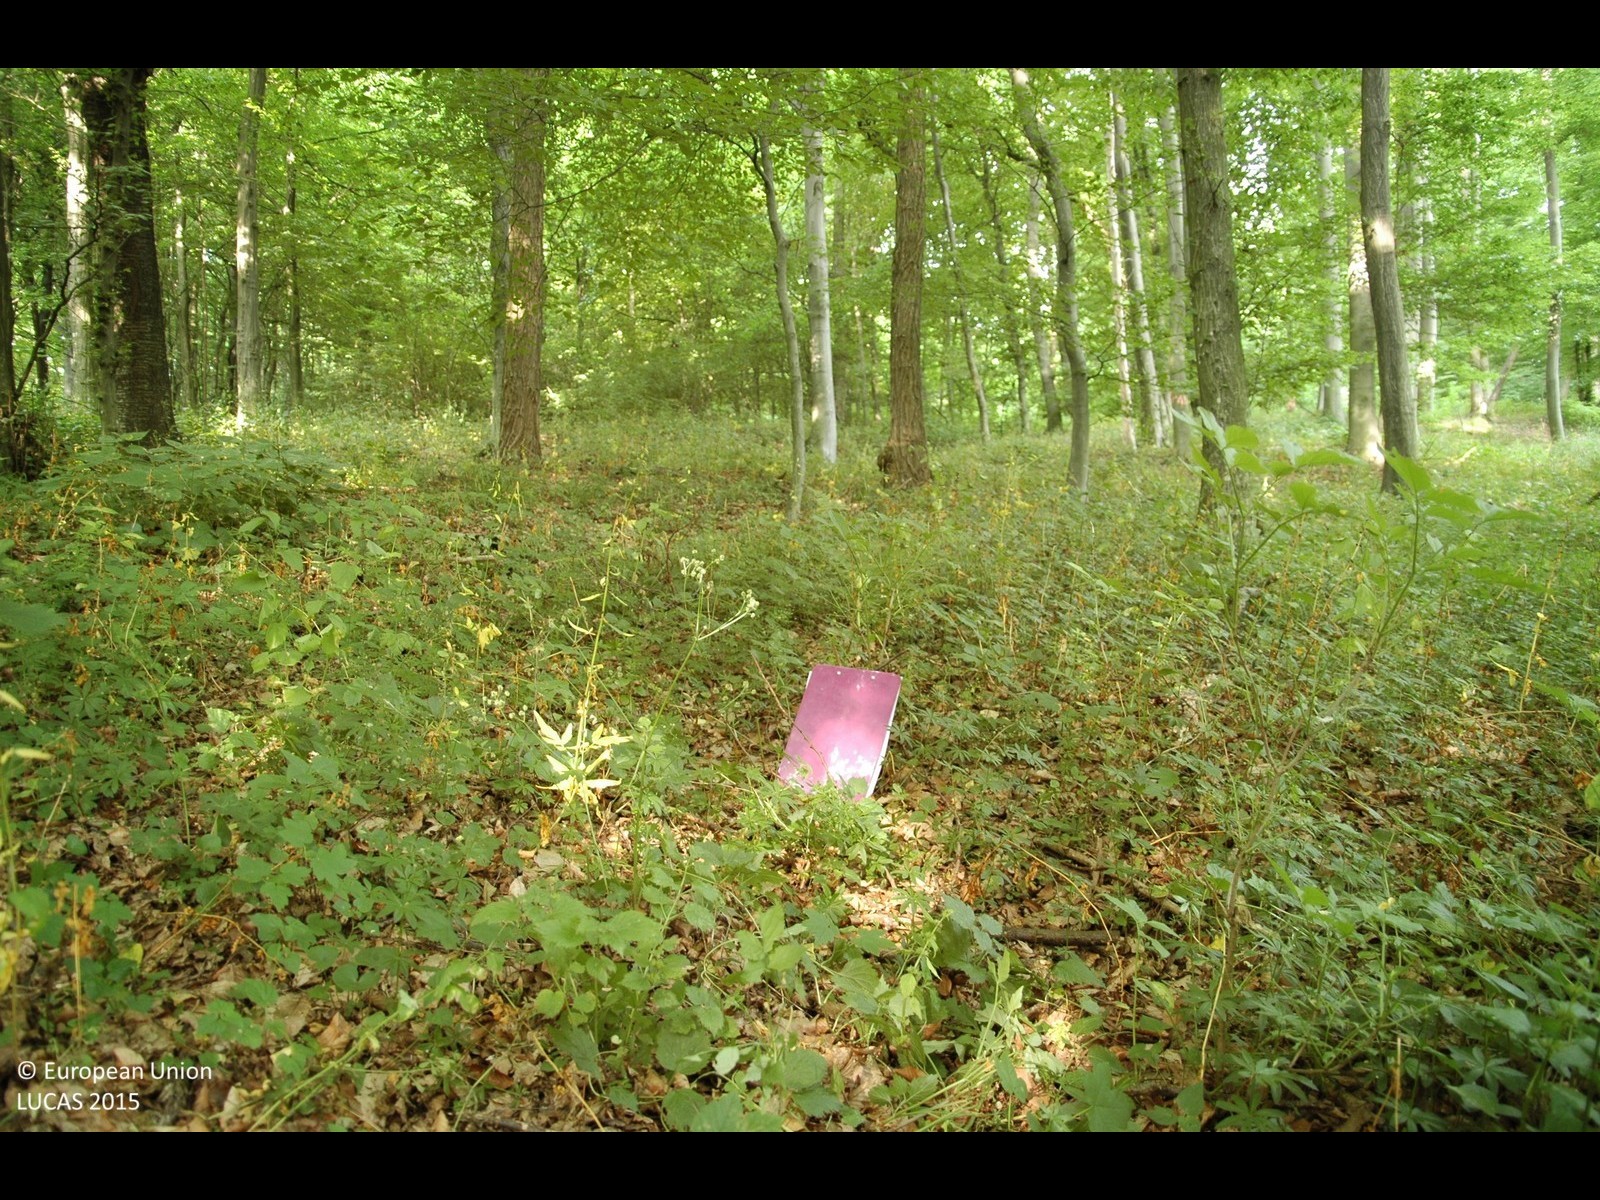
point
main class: Woodland
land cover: Broadleaved woodland
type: beech forest
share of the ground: > 75 %
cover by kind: broadleaved forest trees 100 %
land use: Forestry
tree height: > 5 m
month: June
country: HR
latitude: 46.4879
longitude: 16.3450
